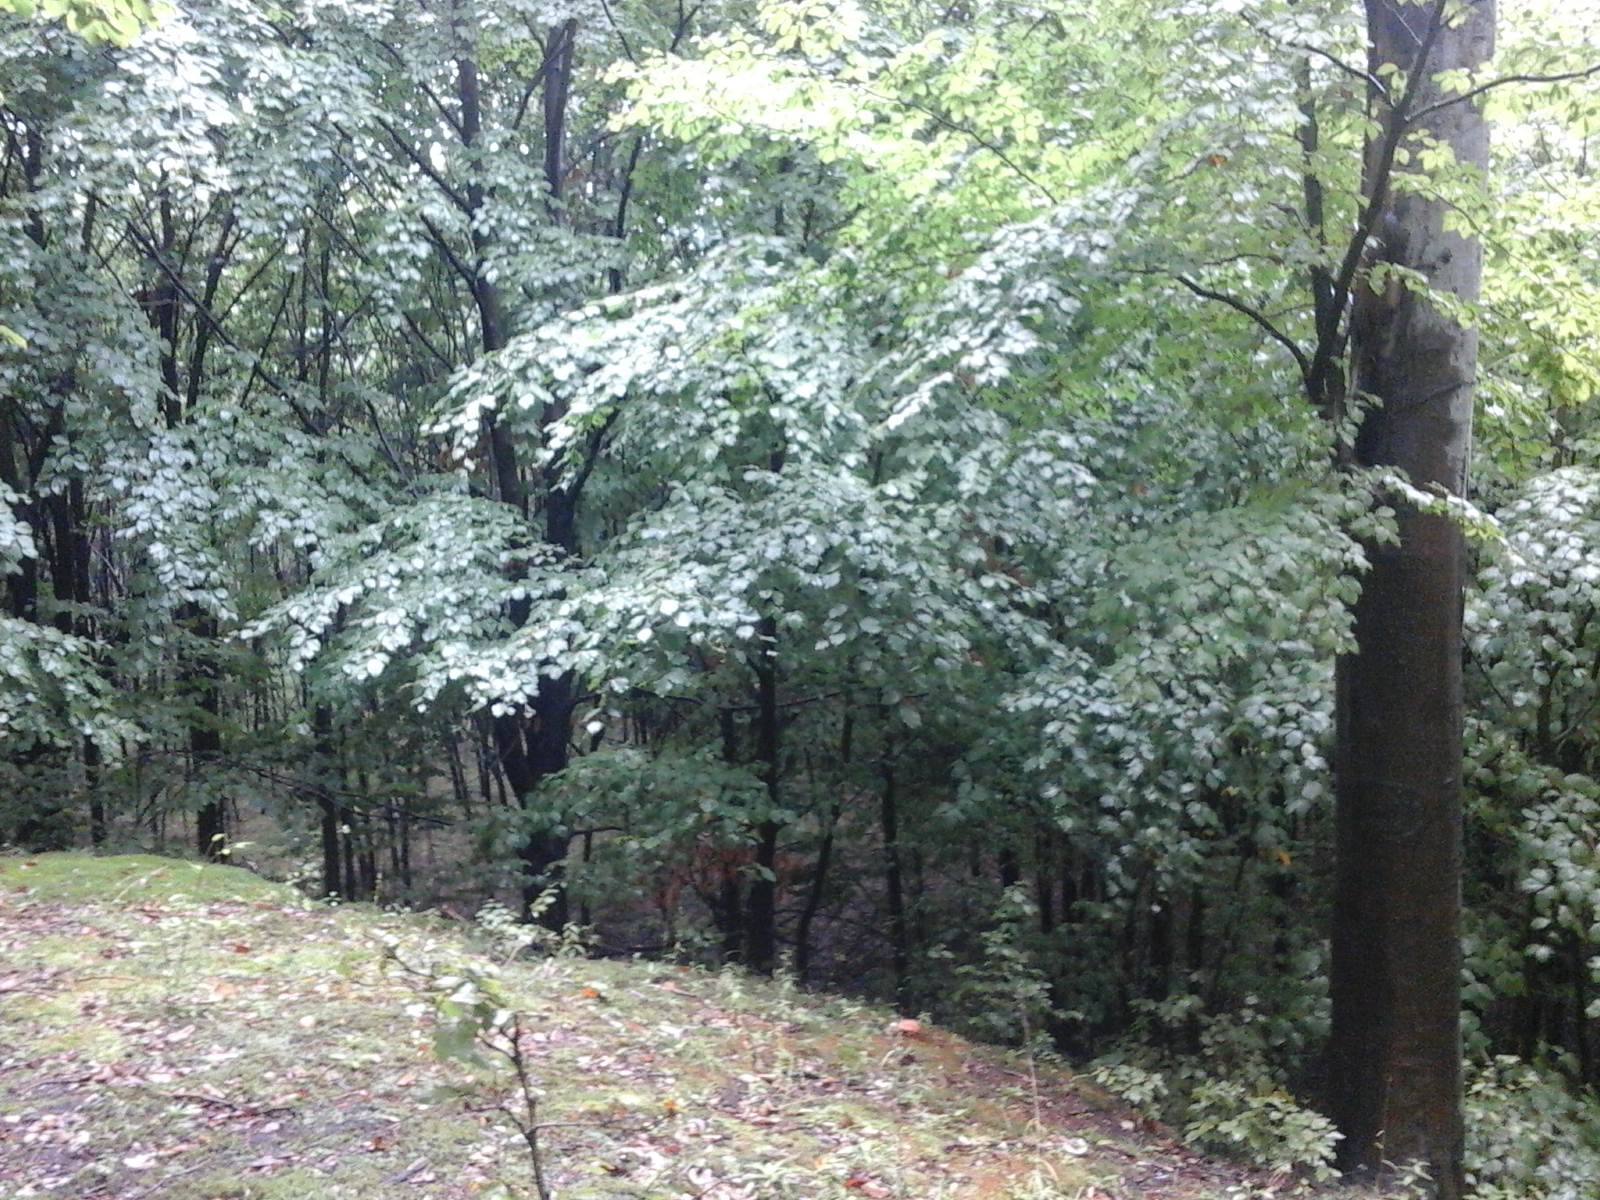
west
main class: Woodland
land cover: Broadleaved woodland
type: beech forest
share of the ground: > 75 %
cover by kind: broadleaved forest trees 100 %
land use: Forestry
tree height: > 5 m
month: September
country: RO
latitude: 45.0435
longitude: 23.7088
